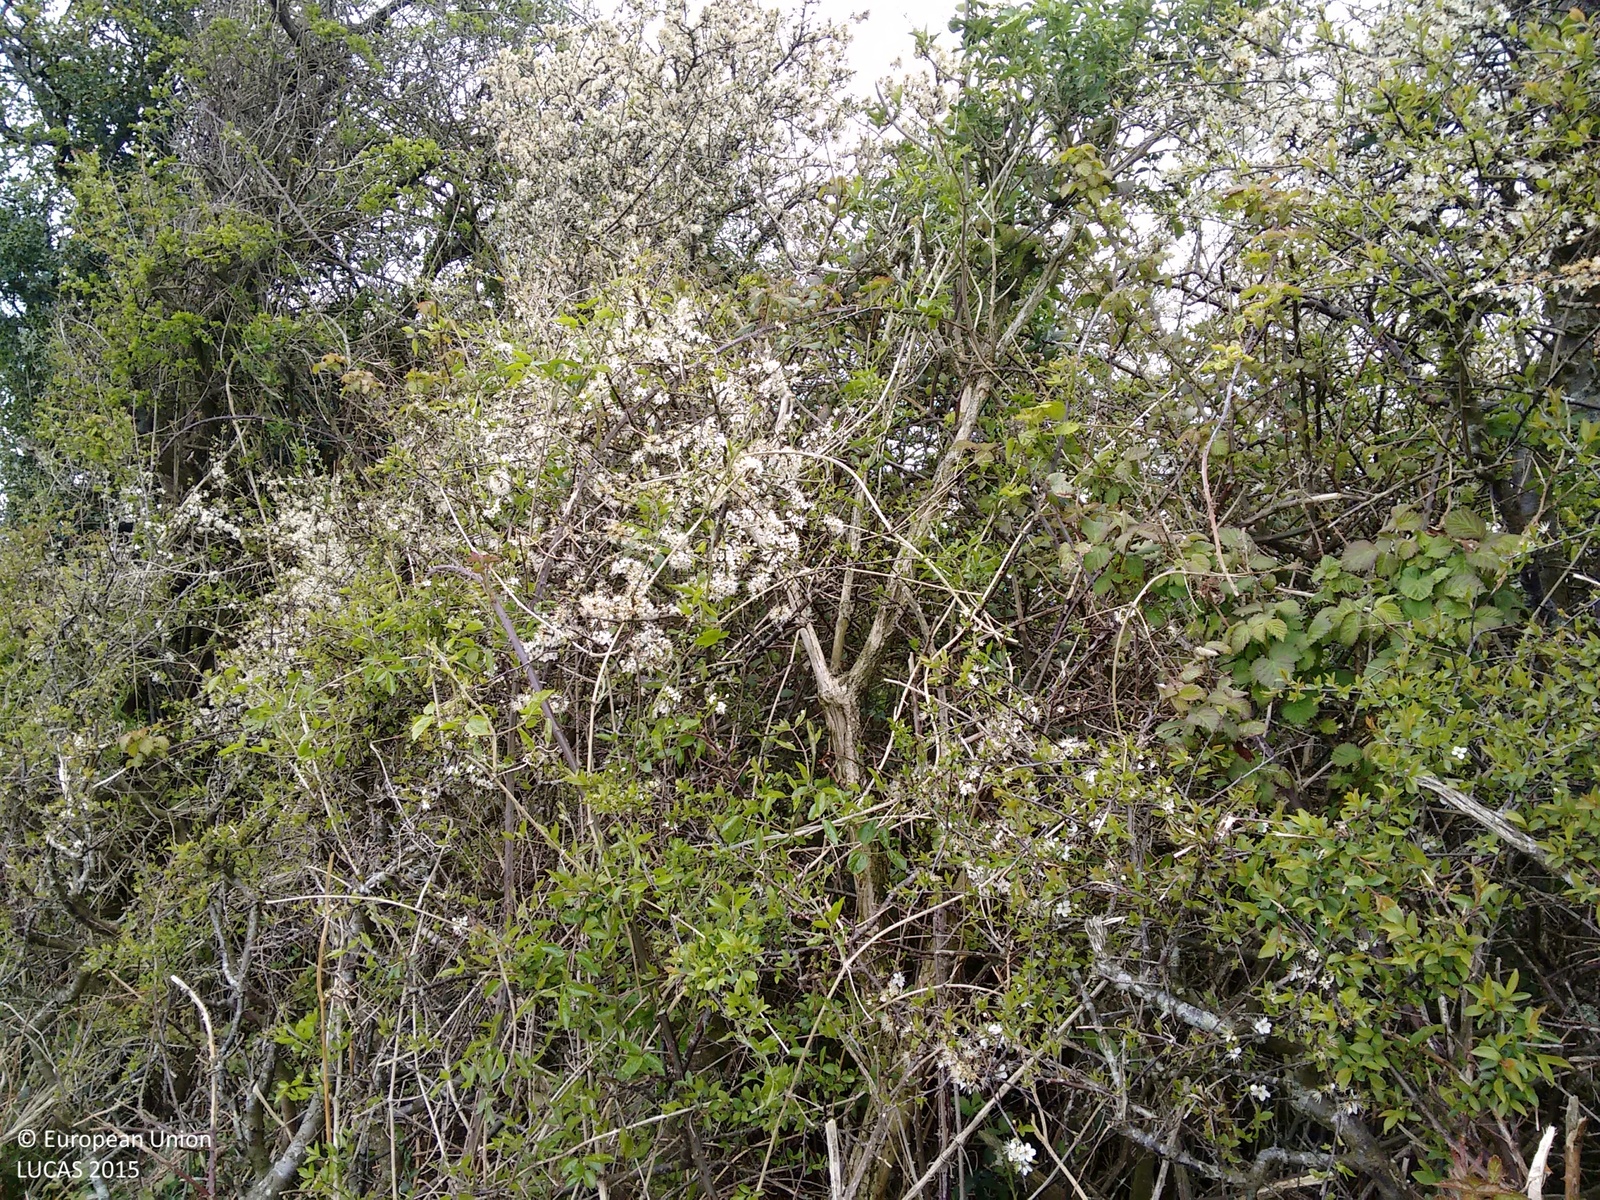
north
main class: Shrubland
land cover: Shrubland with sparse tree cover
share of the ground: > 75 %
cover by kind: shrubs 95 %, broadleaved forest trees 5 %
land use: Agriculture (excluding fallow land and kitchen gardens)
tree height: < 5 m
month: May
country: GB
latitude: 51.0697
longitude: -0.9613
